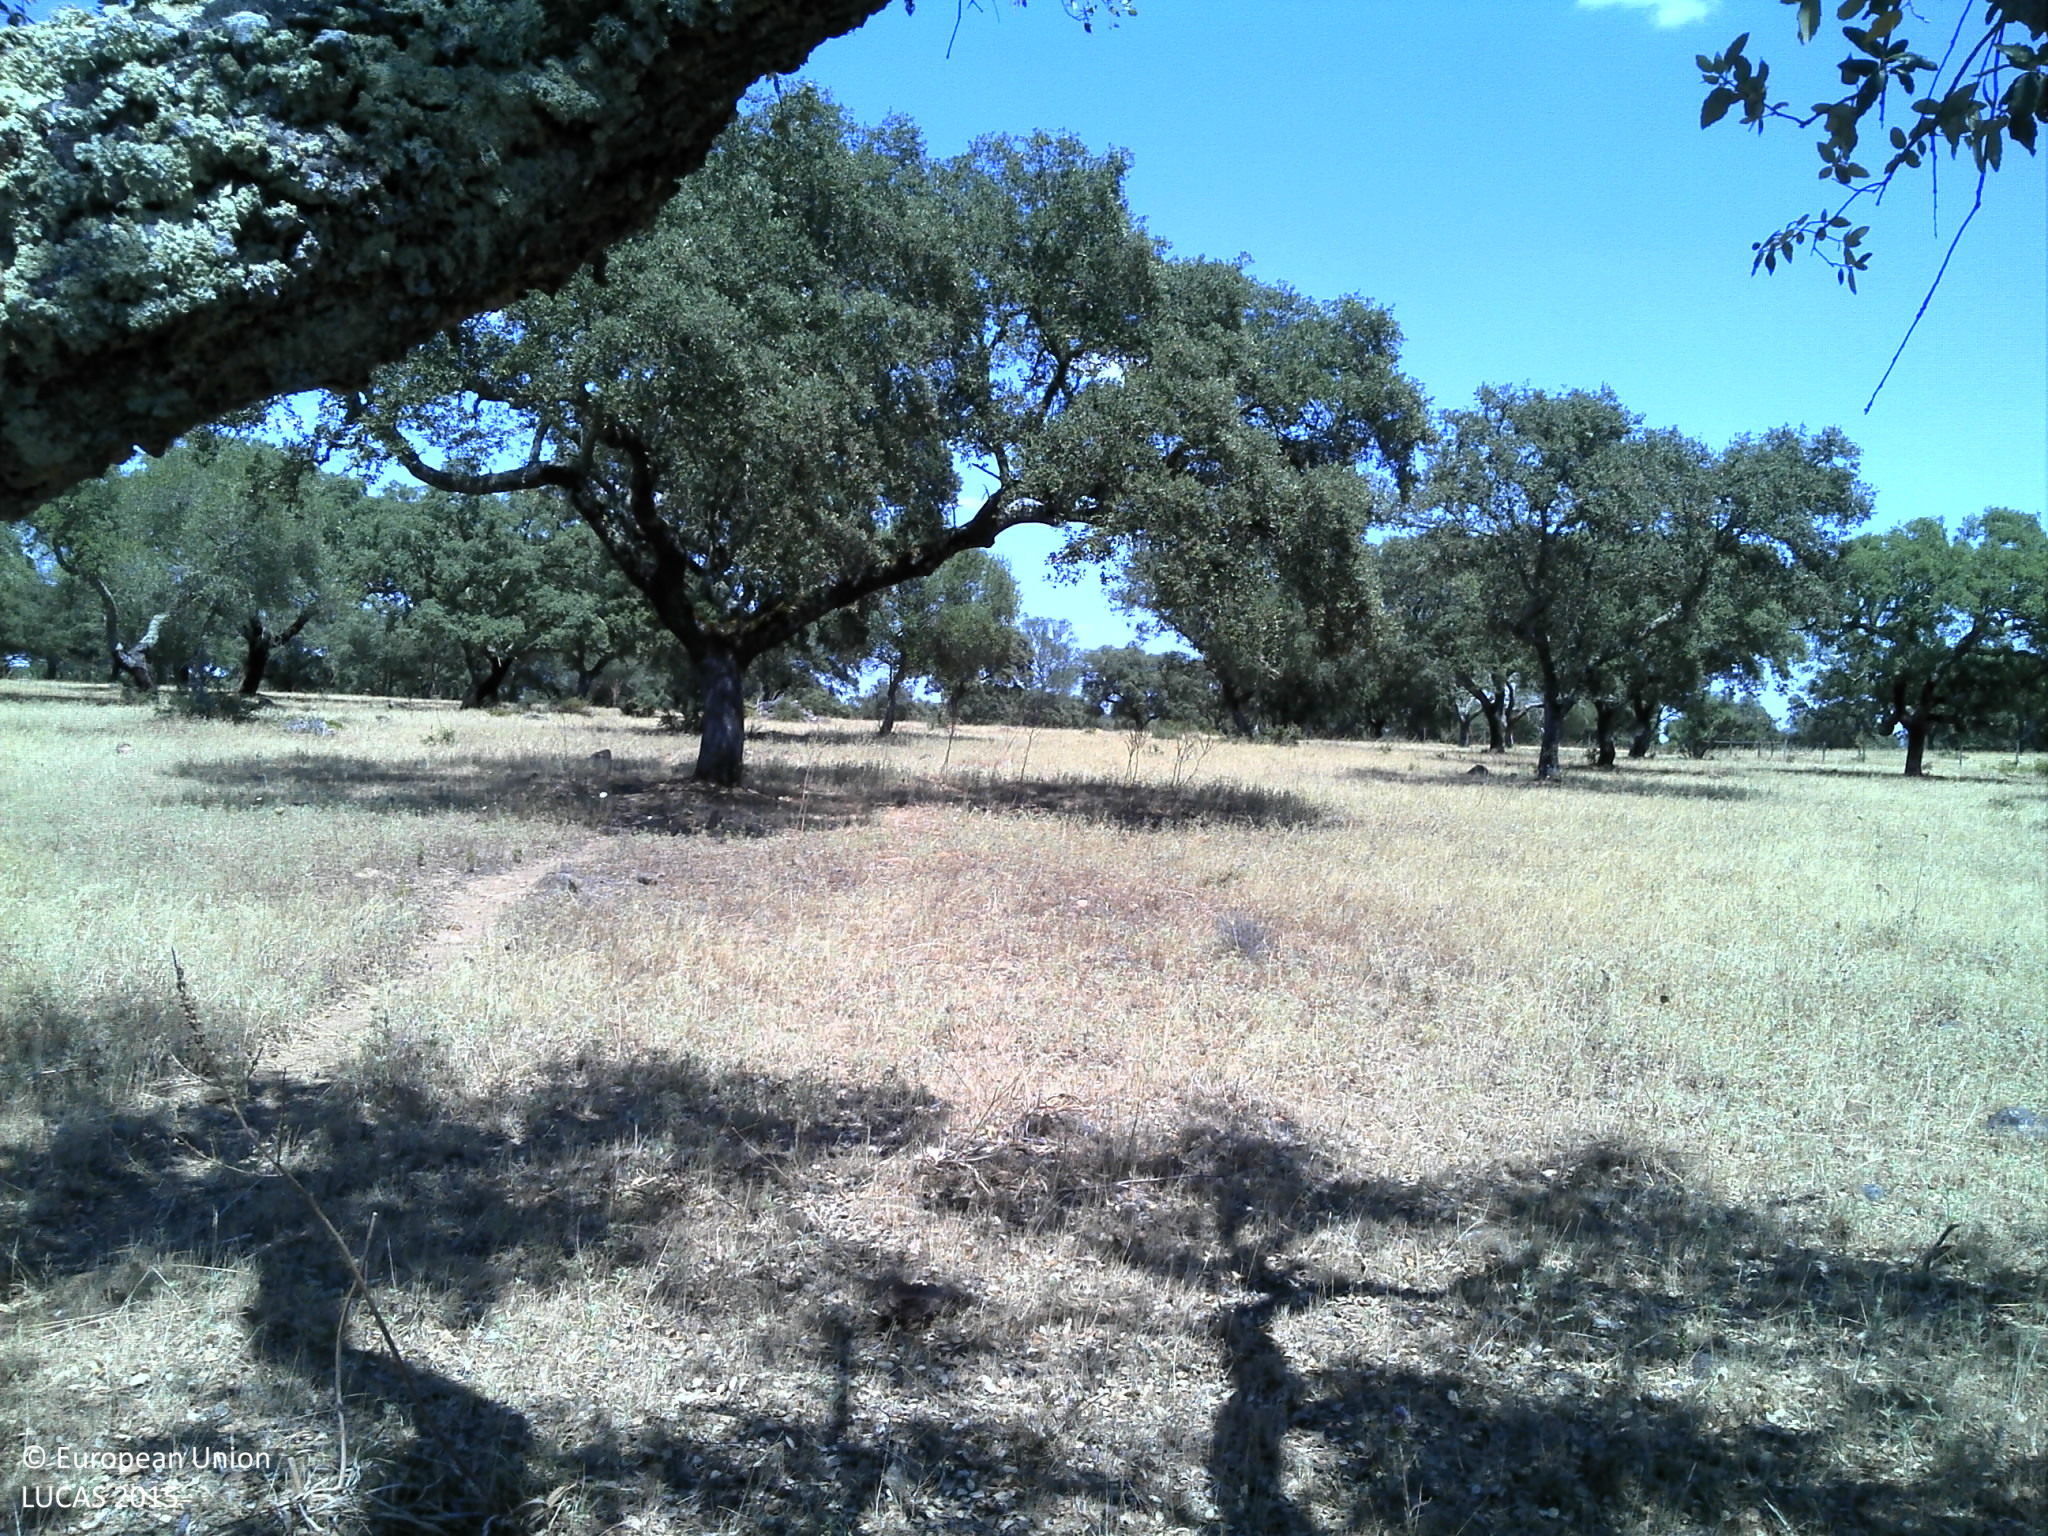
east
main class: Woodland
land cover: Broadleaved woodland
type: broadleaved evergreen forest
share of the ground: 10 - 25 %
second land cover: Grassland without tree/shrub cover
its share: 25 - 50 %
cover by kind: unconsolidated bare surface 50 %, broadleaved forest trees 25 %, herbaceous plants 25 %
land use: Forestry
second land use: Agriculture (excluding fallow land and kitchen gardens)
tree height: > 5 m
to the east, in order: Broadleaved woodland; Grassland without tree/shrub cover; Broadleaved woodland; Tracks; Fences; Broadleaved woodland
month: June
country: PT
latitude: 38.3537
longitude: -8.1560
